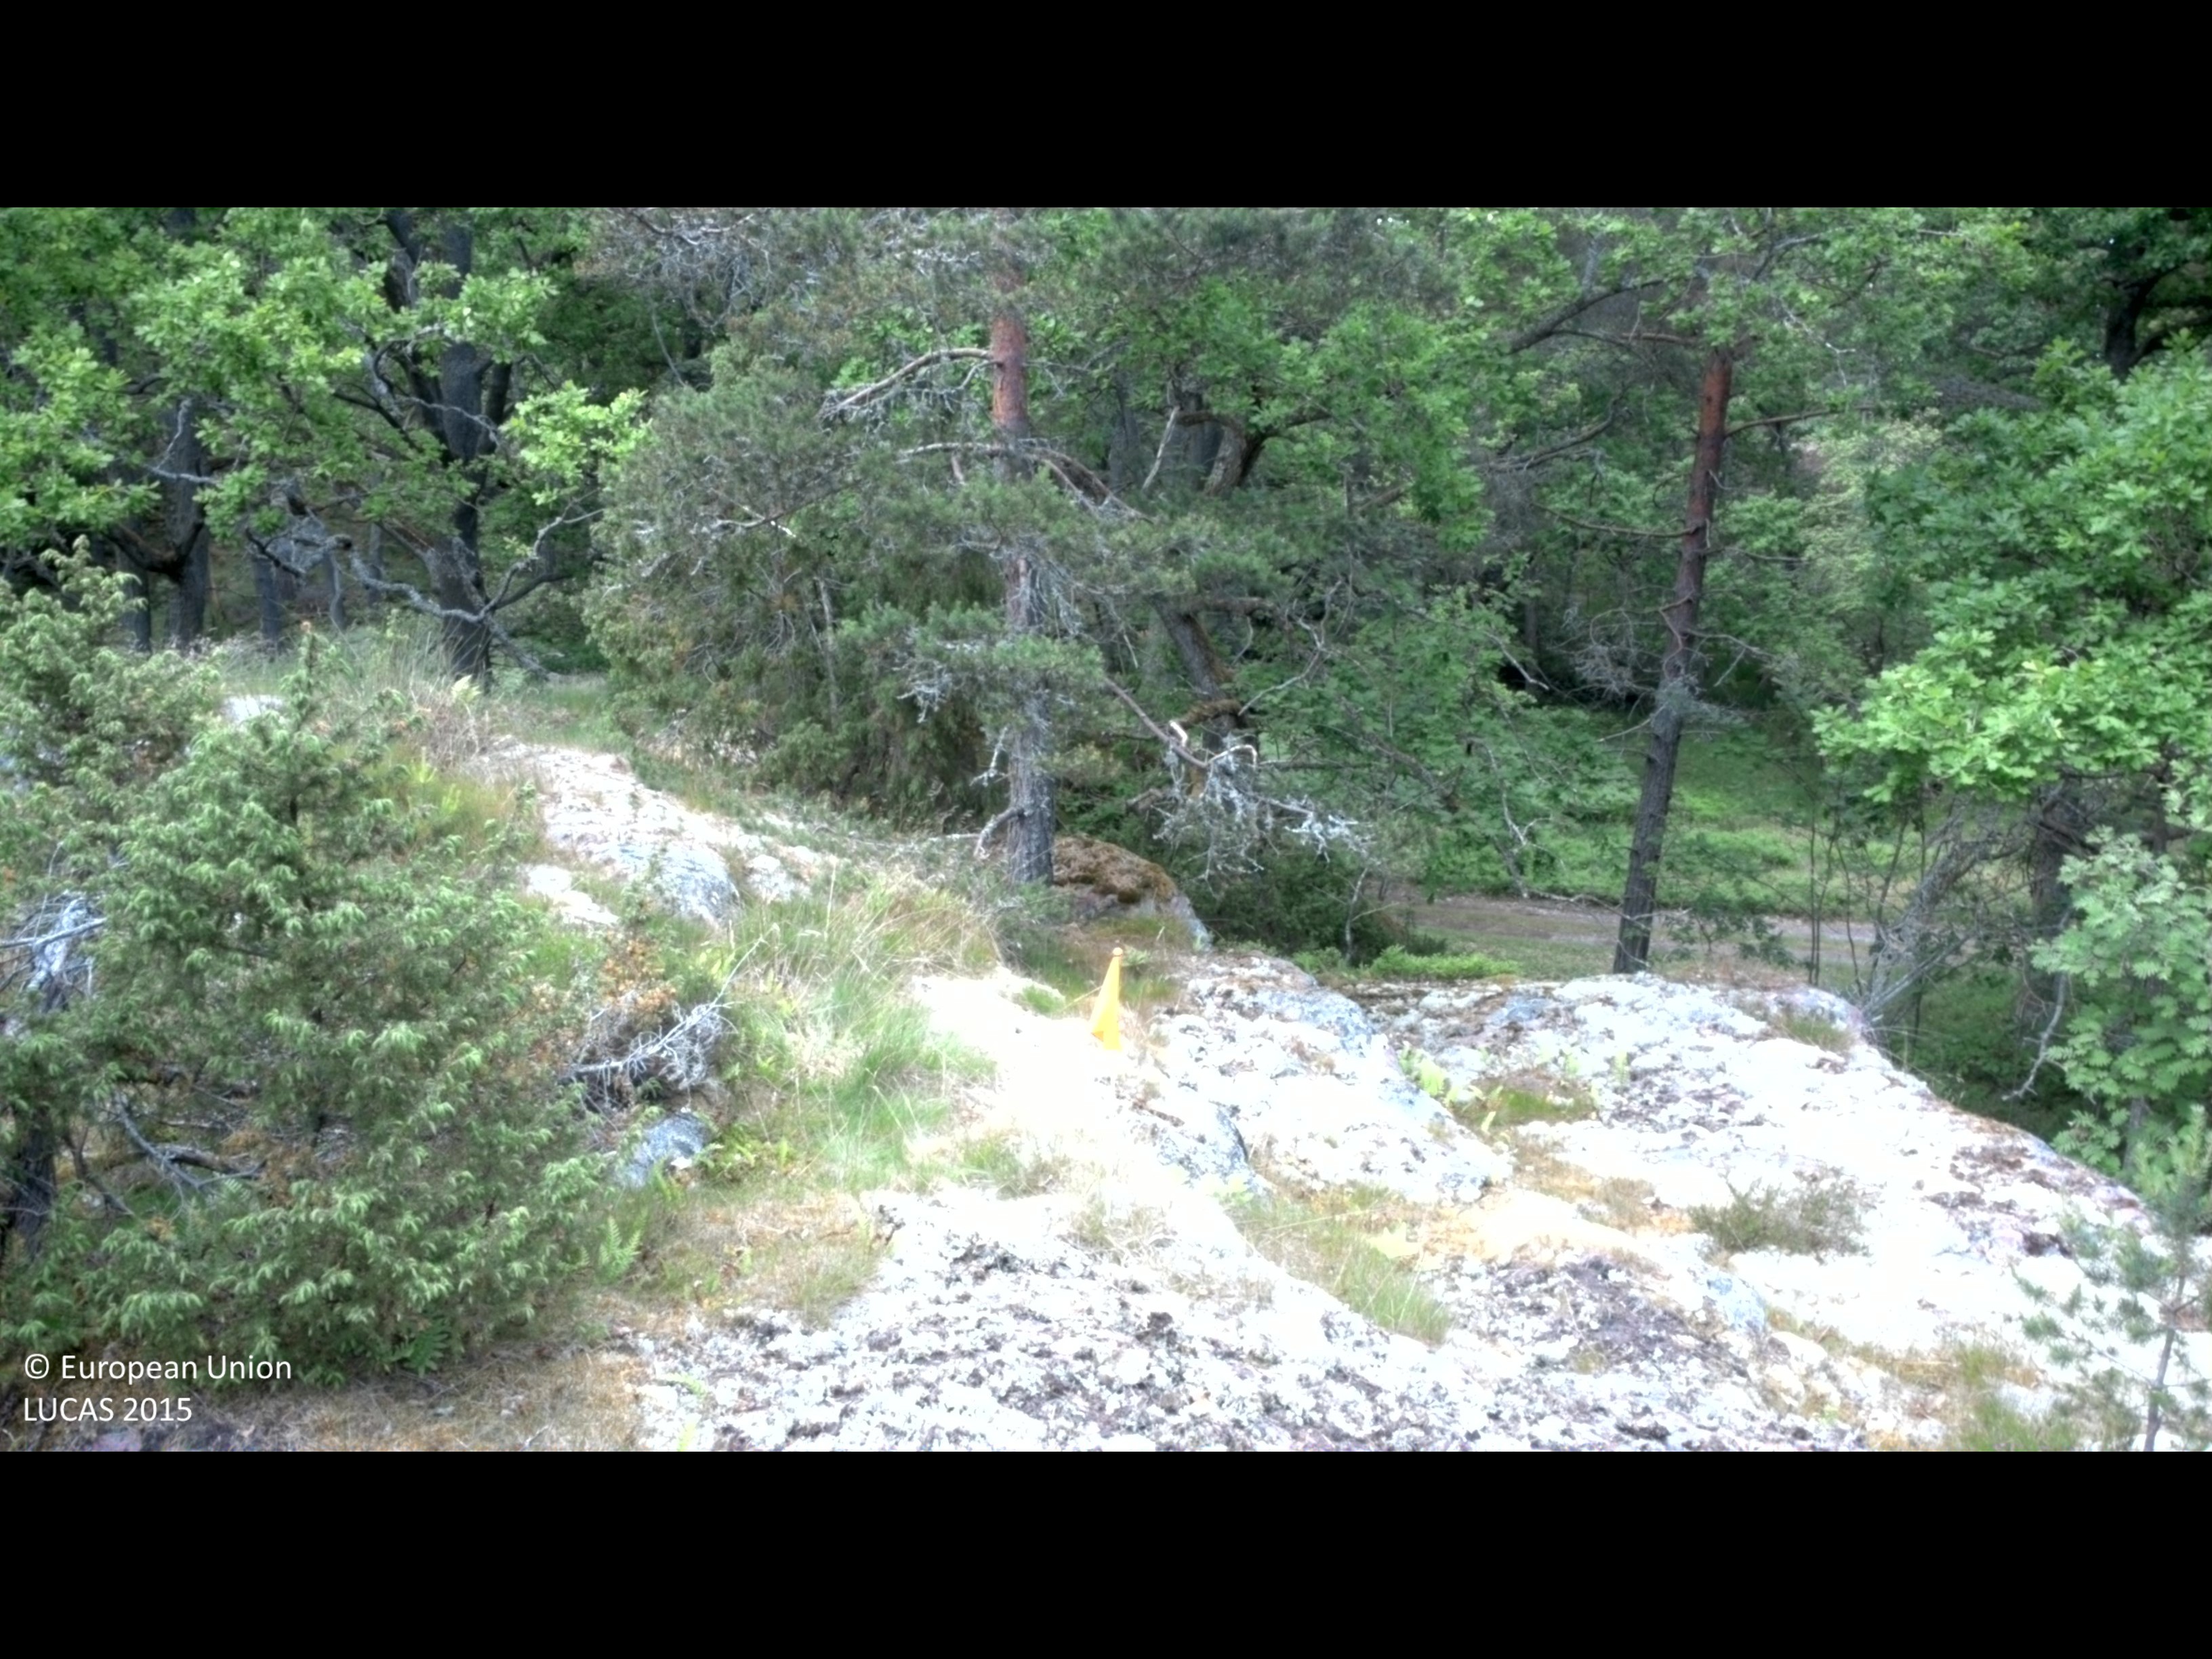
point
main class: Woodland
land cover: Pine dominated mixed woodland
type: hemiboreal forest and nemoral coniferous forest and mixed broadleaved-coniferous forest
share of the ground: 25 - 50 %
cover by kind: lichens and mosses 35 %, coniferous forest trees 30 %, broadleaved forest trees 20 %, unconsolidated bare surface 10 %, shrubs 5 %
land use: Forestry
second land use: Amenities, museums, leisure
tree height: > 5 m
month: June
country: SE
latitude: 57.7274
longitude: 16.6991
